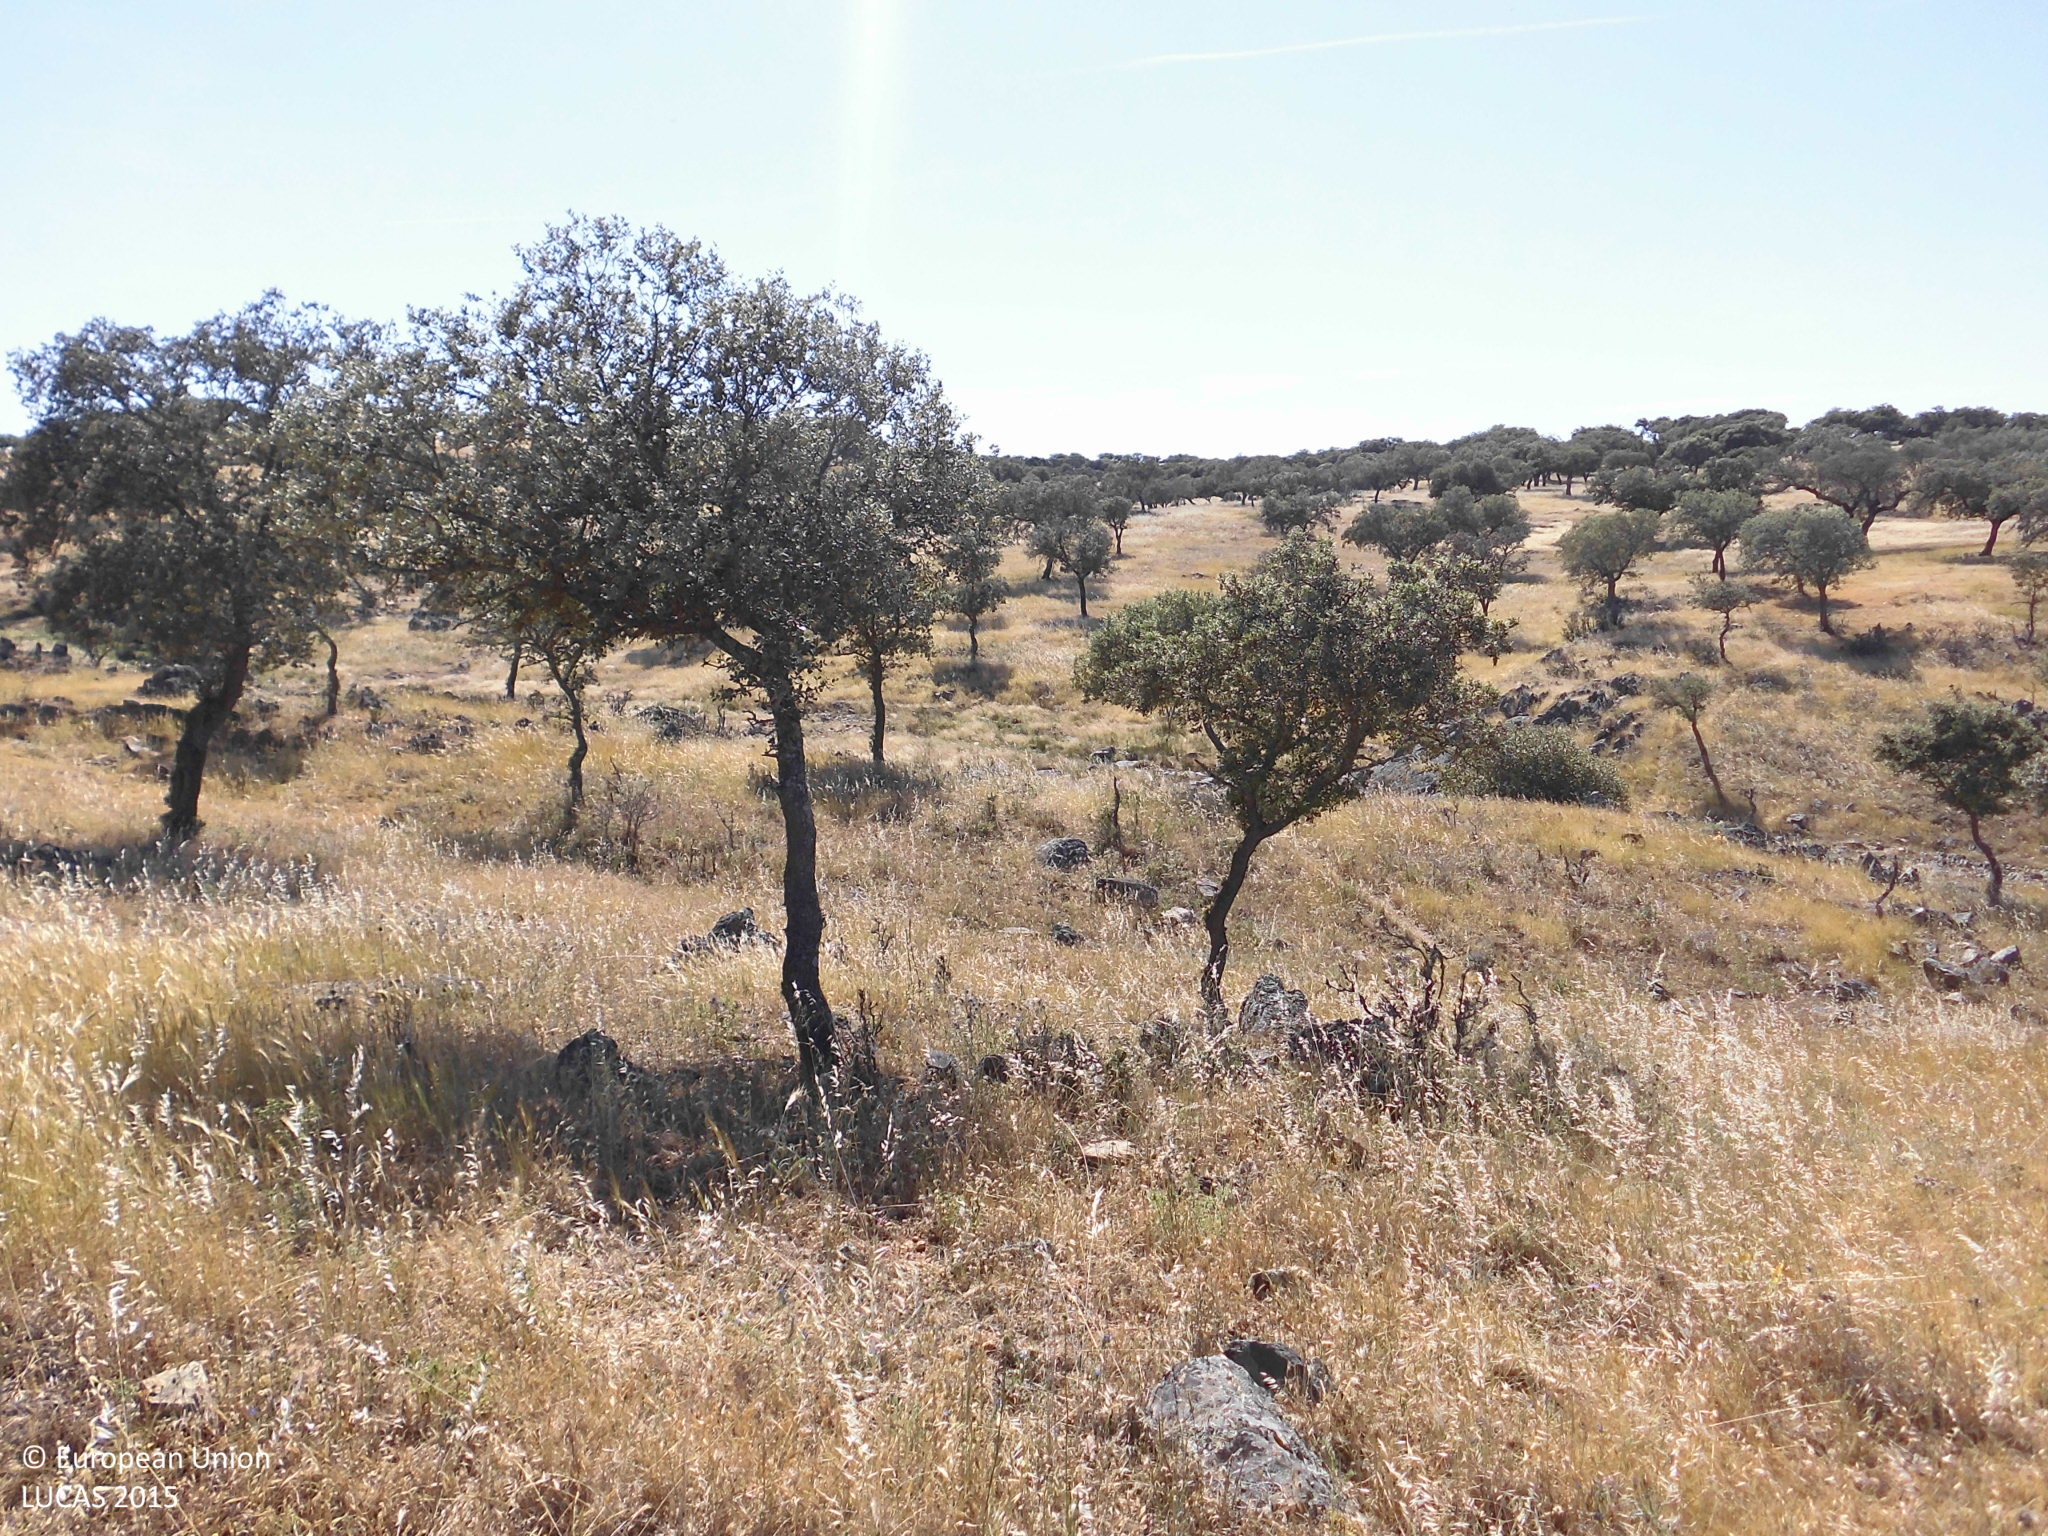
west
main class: Woodland
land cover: Broadleaved woodland
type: broadleaved evergreen forest
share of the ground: 10 - 25 %
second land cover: Grassland without tree/shrub cover
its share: > 75 %
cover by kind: herbaceous plants 85 %, broadleaved forest trees 15 %
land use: Forestry
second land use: Agriculture (excluding fallow land and kitchen gardens)
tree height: > 5 m
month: May
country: ES
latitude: 39.4443
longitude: -6.8445
